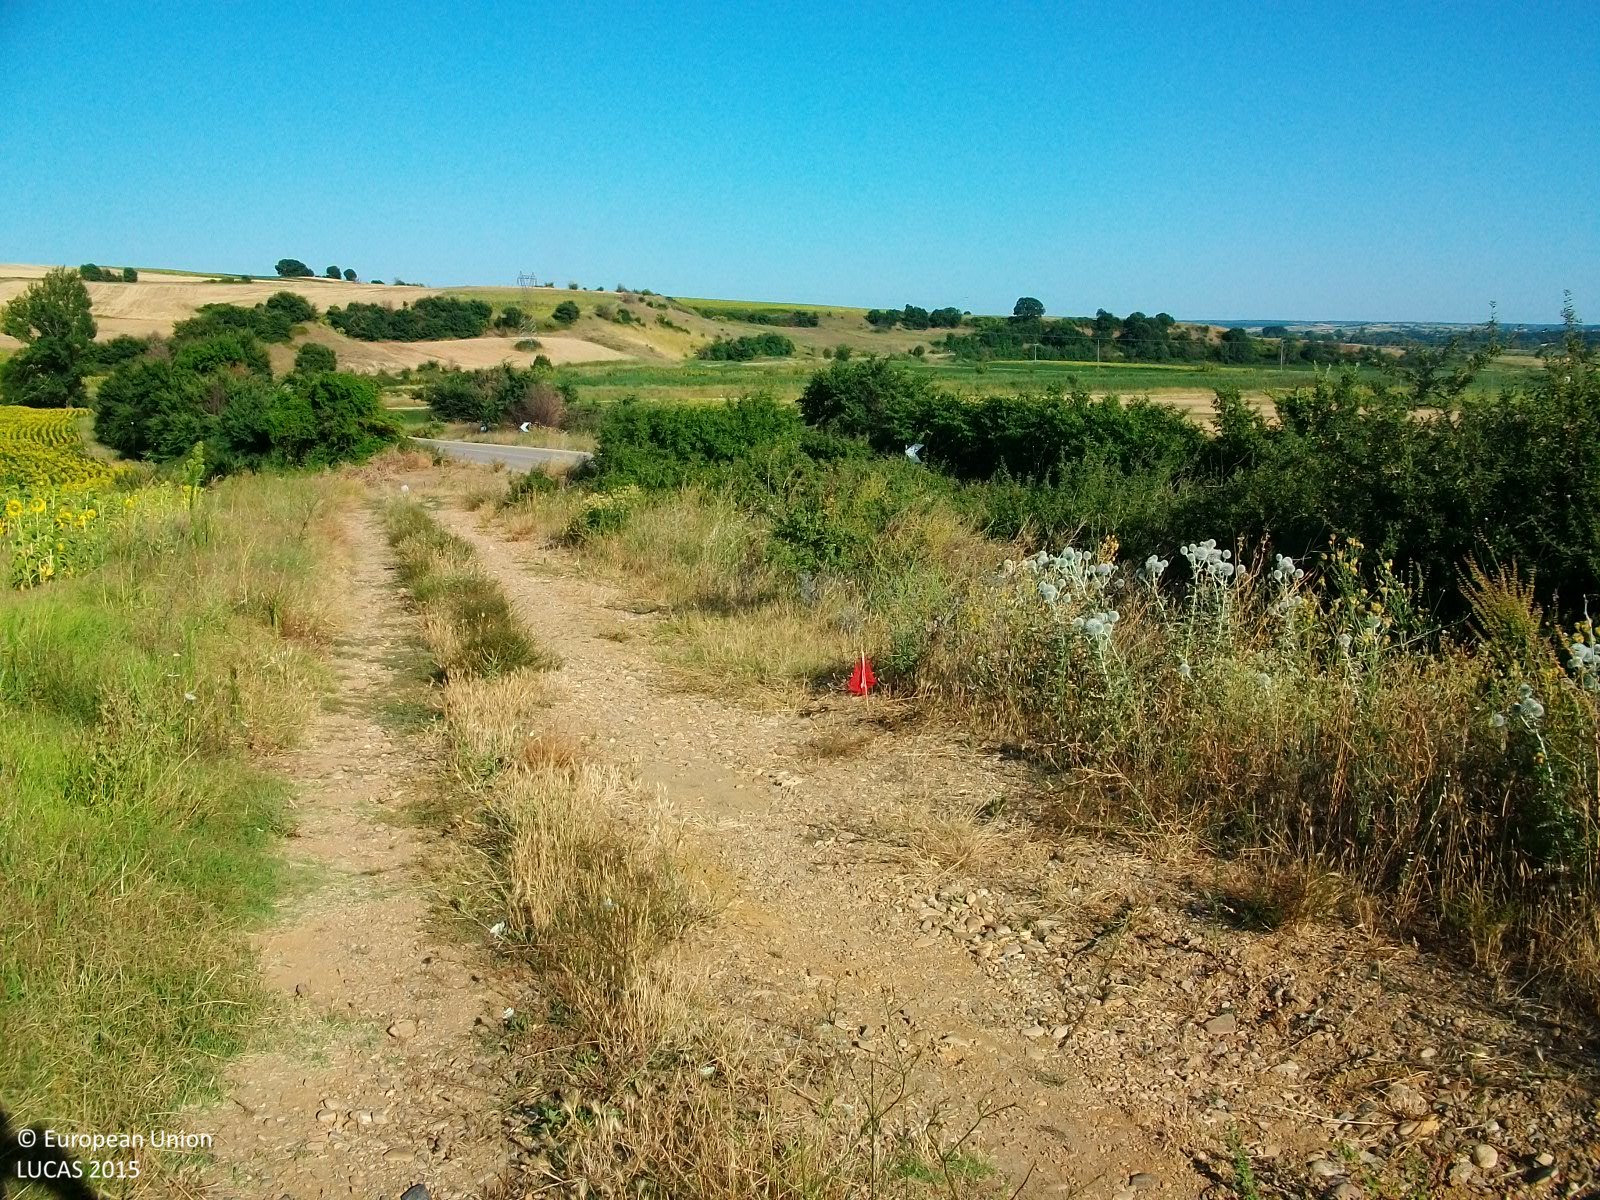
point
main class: Cropland
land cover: Sunflower
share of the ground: > 75 %
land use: Agriculture (excluding fallow land and kitchen gardens)
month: July
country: GR
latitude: 41.4530
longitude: 26.2939
